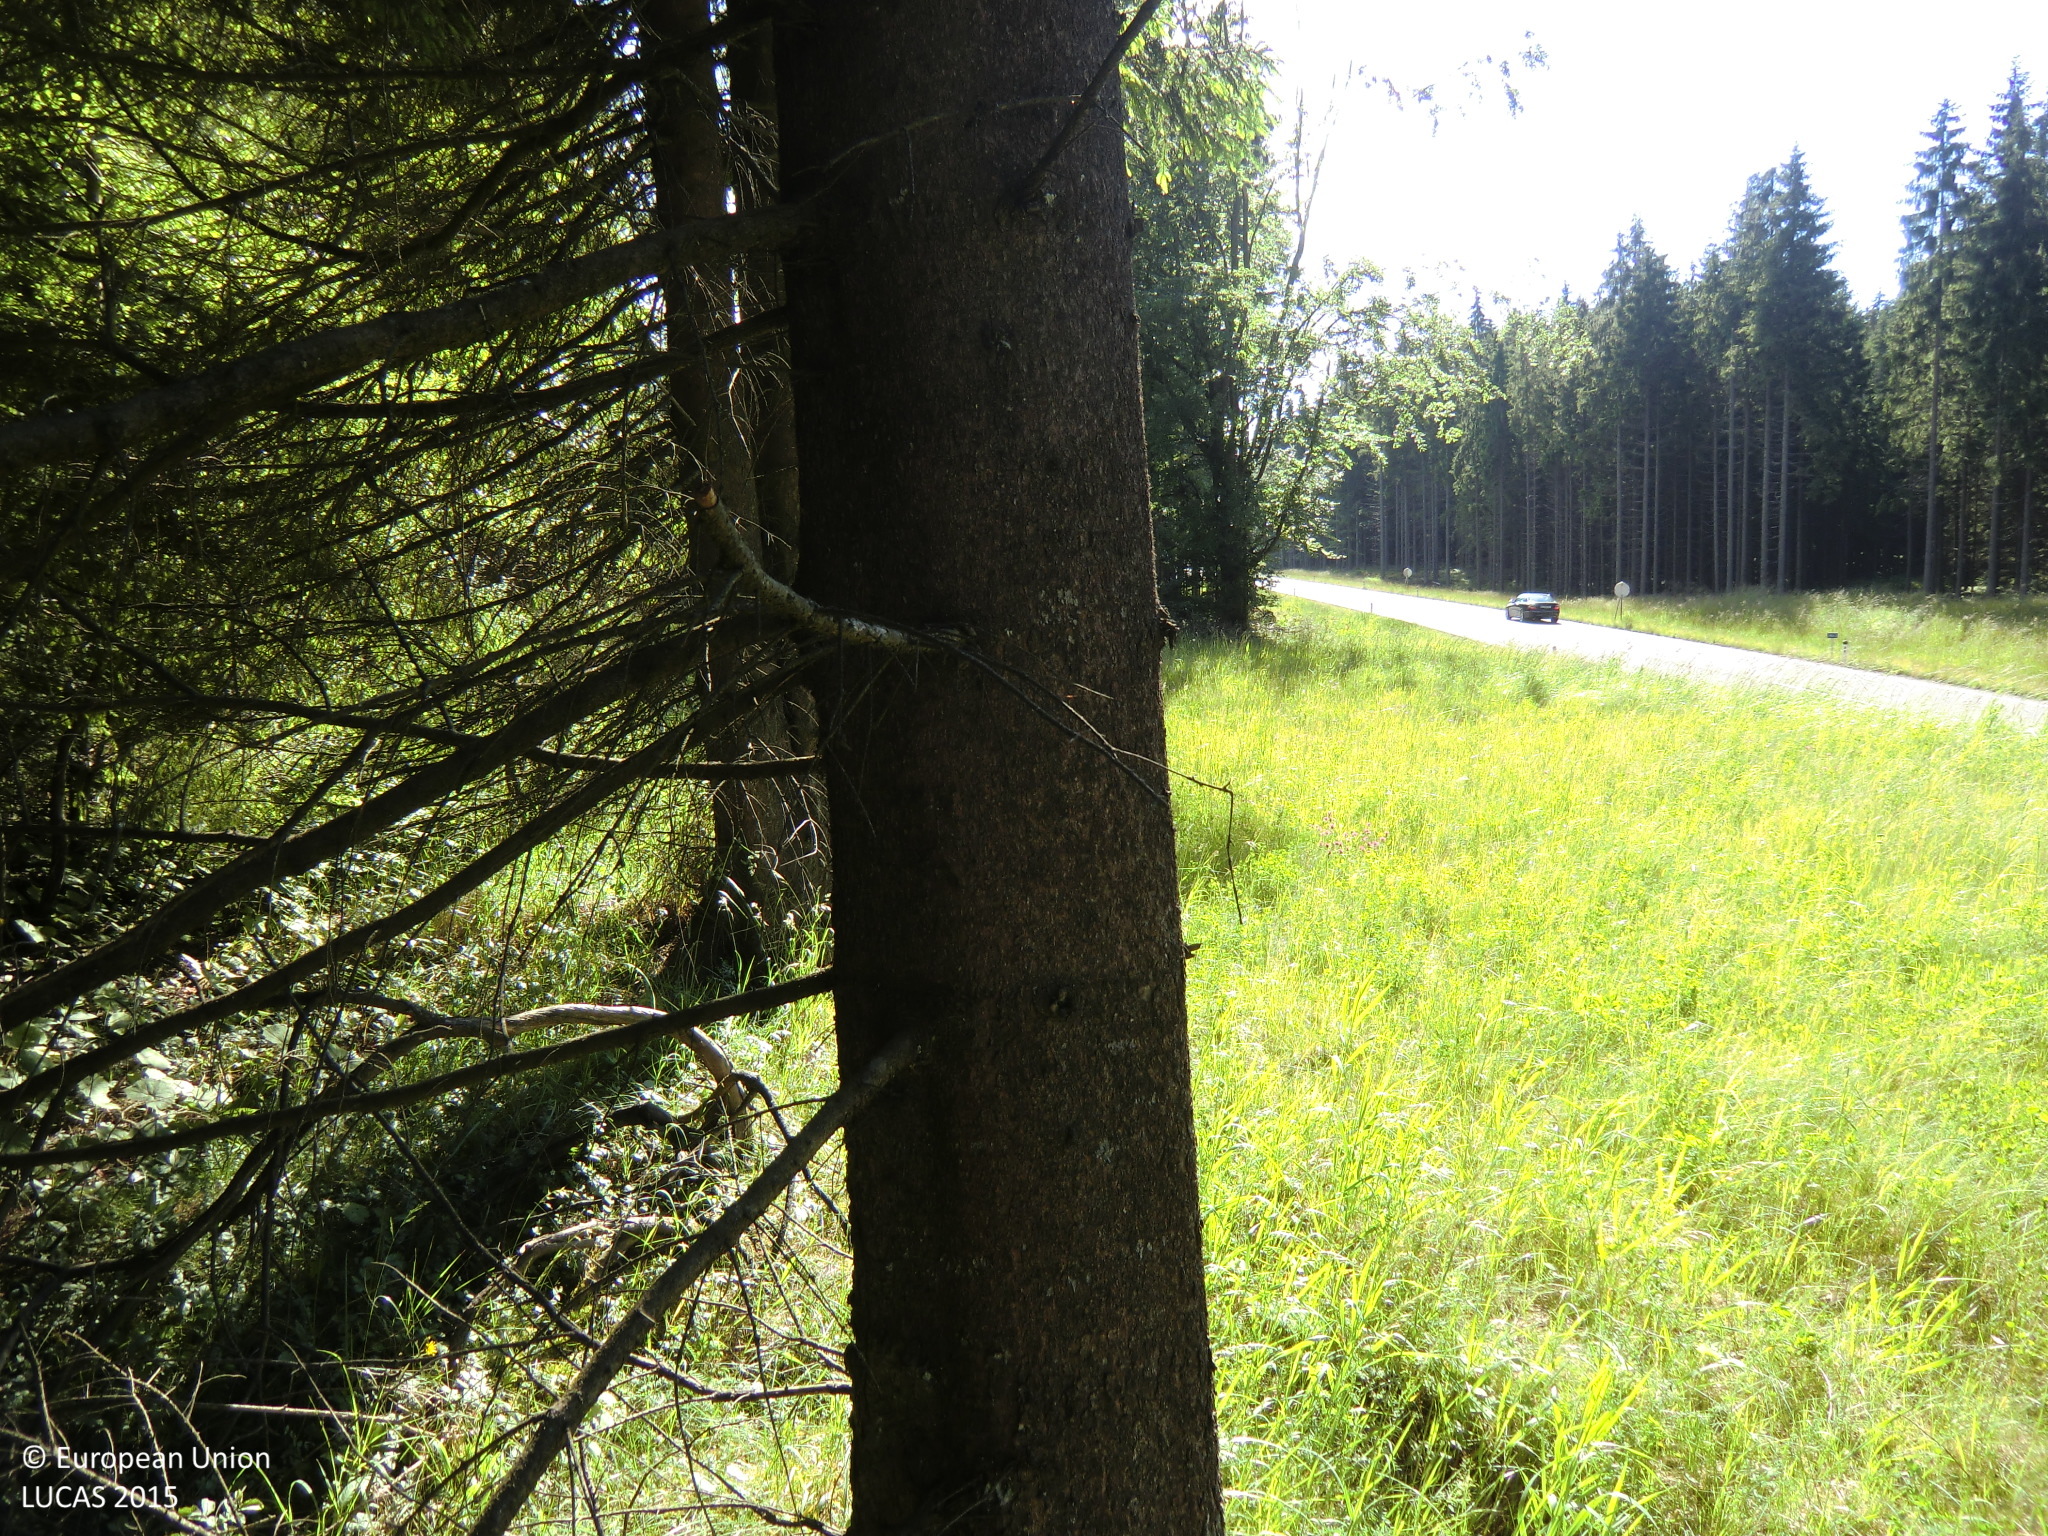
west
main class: Woodland
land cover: Spruce dominated coniferous woodland
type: hemiboreal forest and nemoral coniferous forest and mixed broadleaved-coniferous forest
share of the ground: > 75 %
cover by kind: coniferous forest trees 80 %, herbaceous plants 20 %
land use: Forestry
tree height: > 5 m
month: June
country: AT
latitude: 48.5558
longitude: 14.7025
